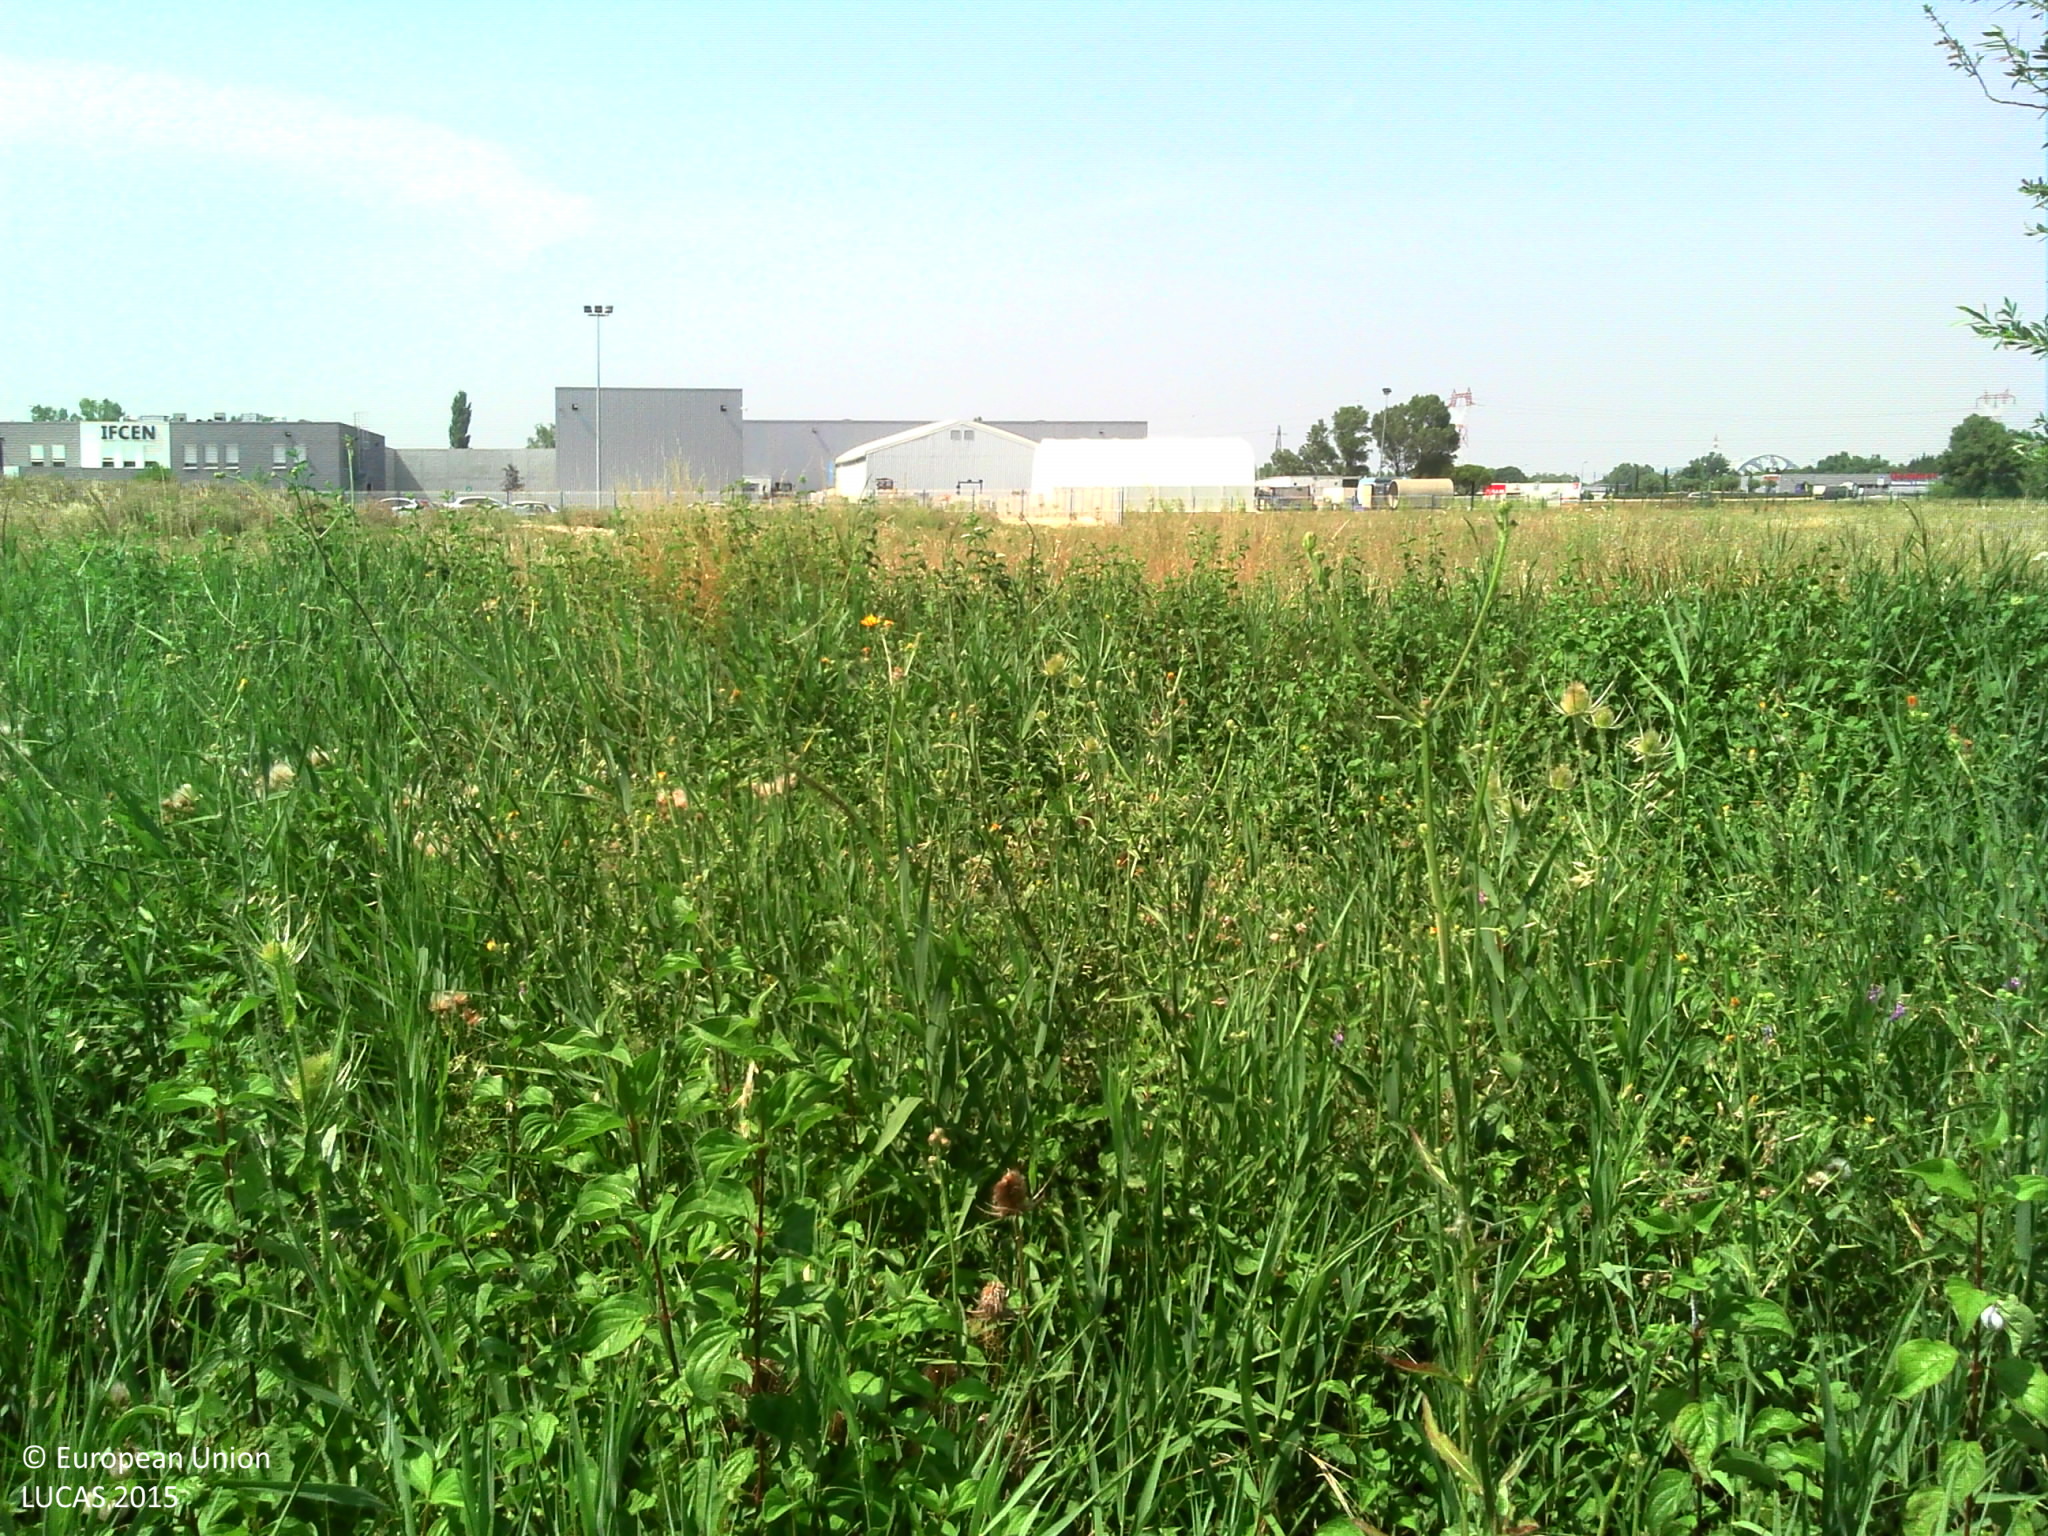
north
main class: Grassland
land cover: Spontaneously vegetated surfaces
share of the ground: > 75 %
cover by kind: herbaceous plants 100 %
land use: Semi-natural and natural areas not in use
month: July
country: FR
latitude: 44.3610
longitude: 4.7249
